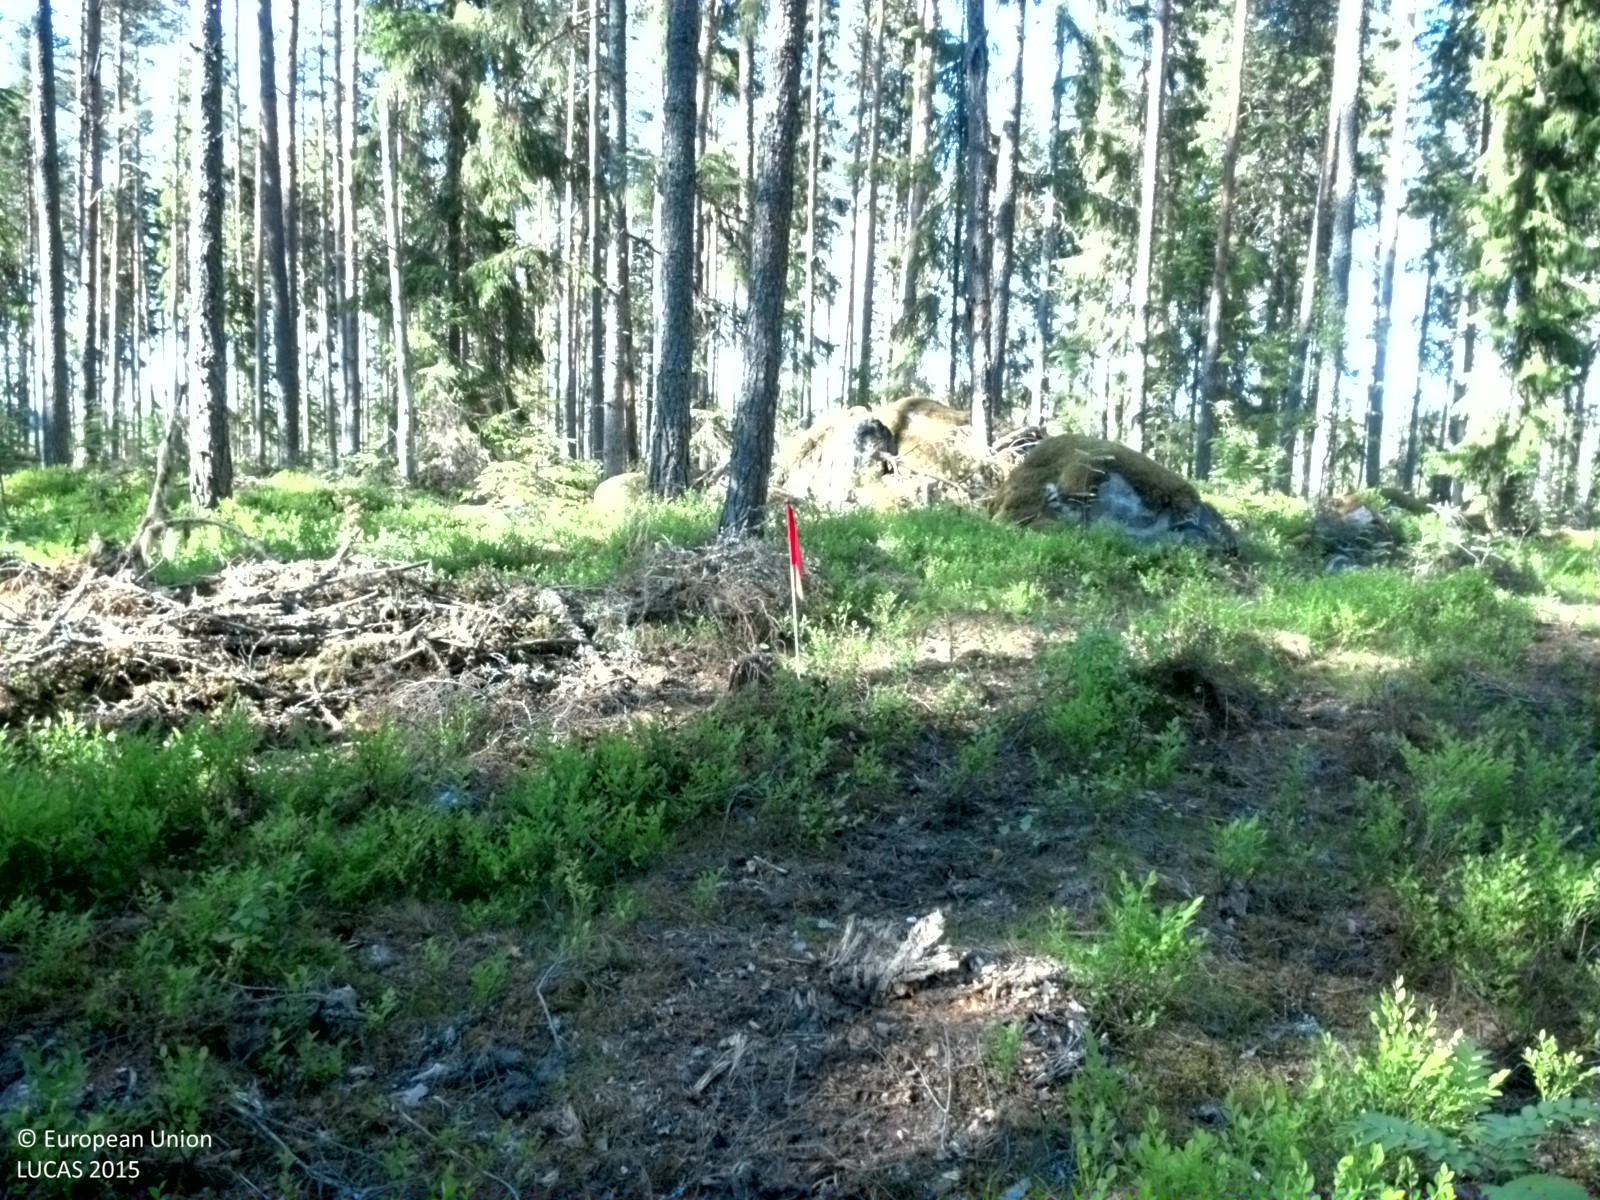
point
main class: Woodland
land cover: Pine dominated coniferous woodland
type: boreal forest
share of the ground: 50 - 75 %
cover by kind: coniferous forest trees 50 %, shrubs 20 %, consolidated bare surface 10 %, herbaceous plants 5 %, lichens and mosses 5 %
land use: Forestry
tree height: > 5 m
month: June
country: SE
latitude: 60.1699
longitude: 17.6888
